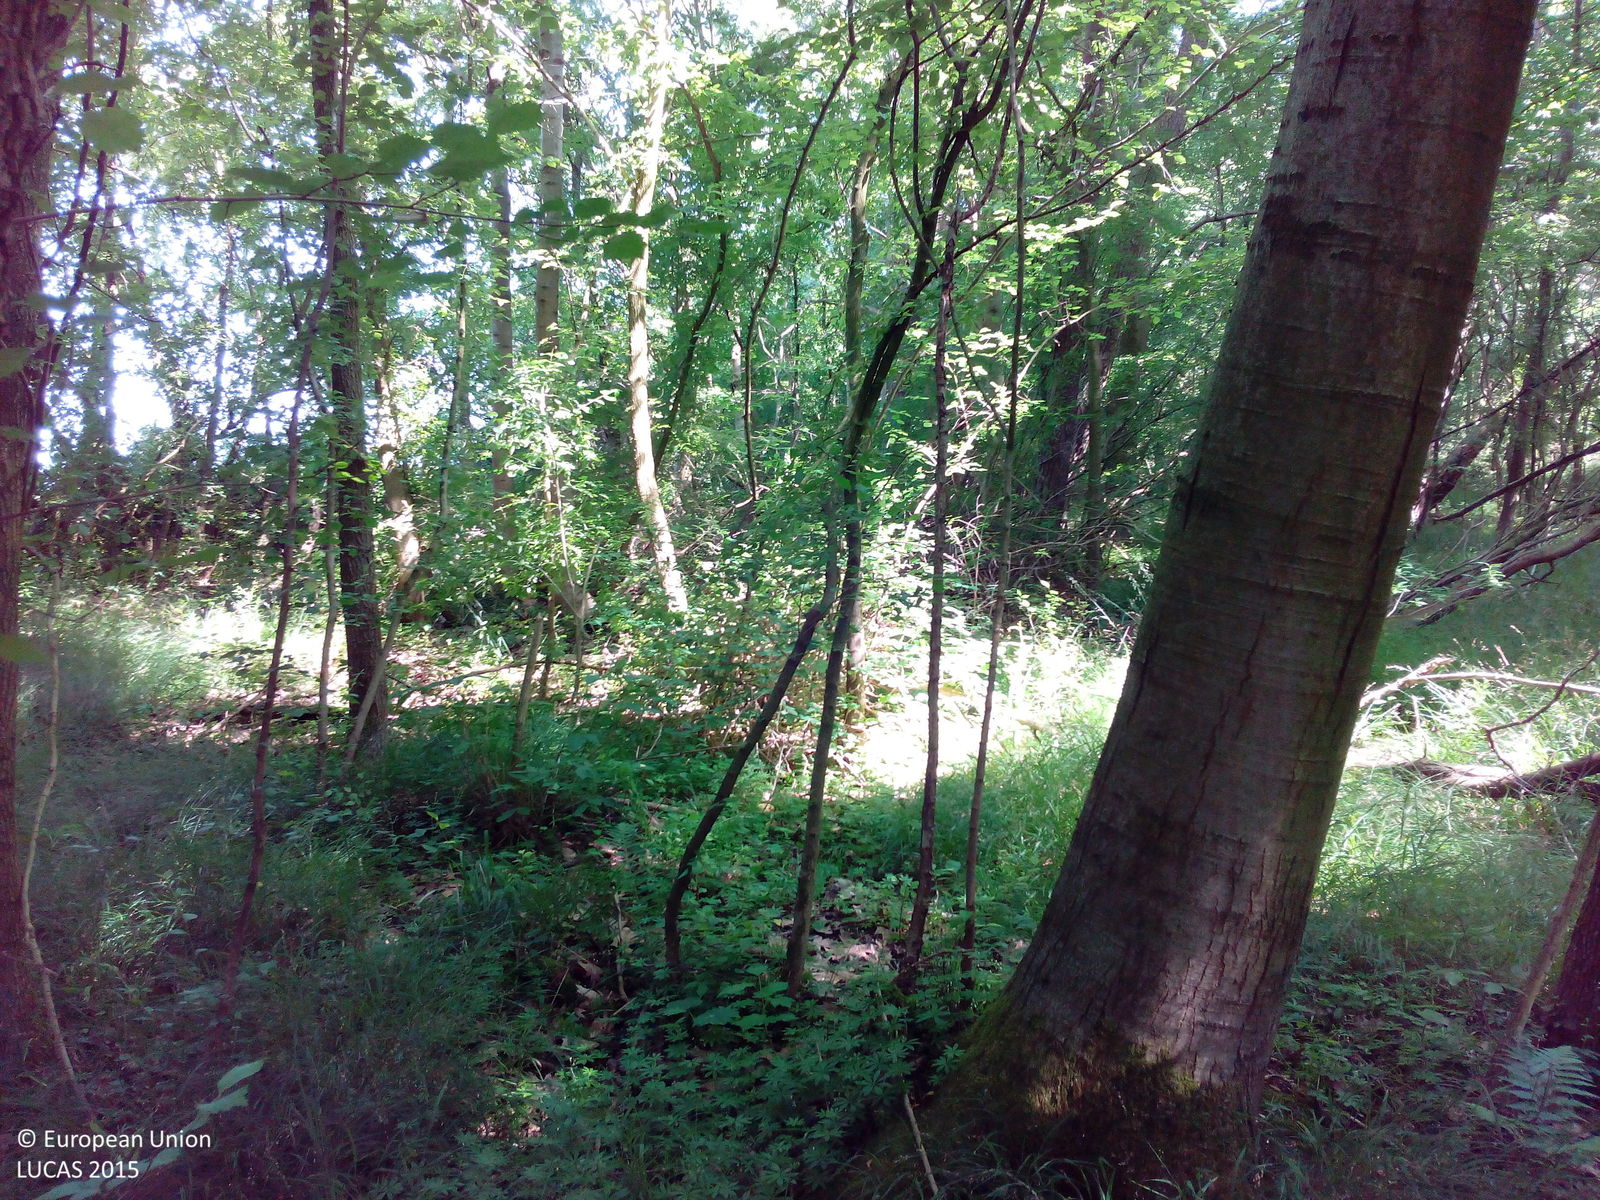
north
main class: Woodland
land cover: Spruce dominated mixed woodland
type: hemiboreal forest and nemoral coniferous forest and mixed broadleaved-coniferous forest
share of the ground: > 75 %
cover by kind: broadleaved forest trees 65 %, coniferous forest trees 25 %, herbaceous plants 10 %
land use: Community services
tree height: > 5 m
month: June
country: DE
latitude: 51.8381
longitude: 9.8694
